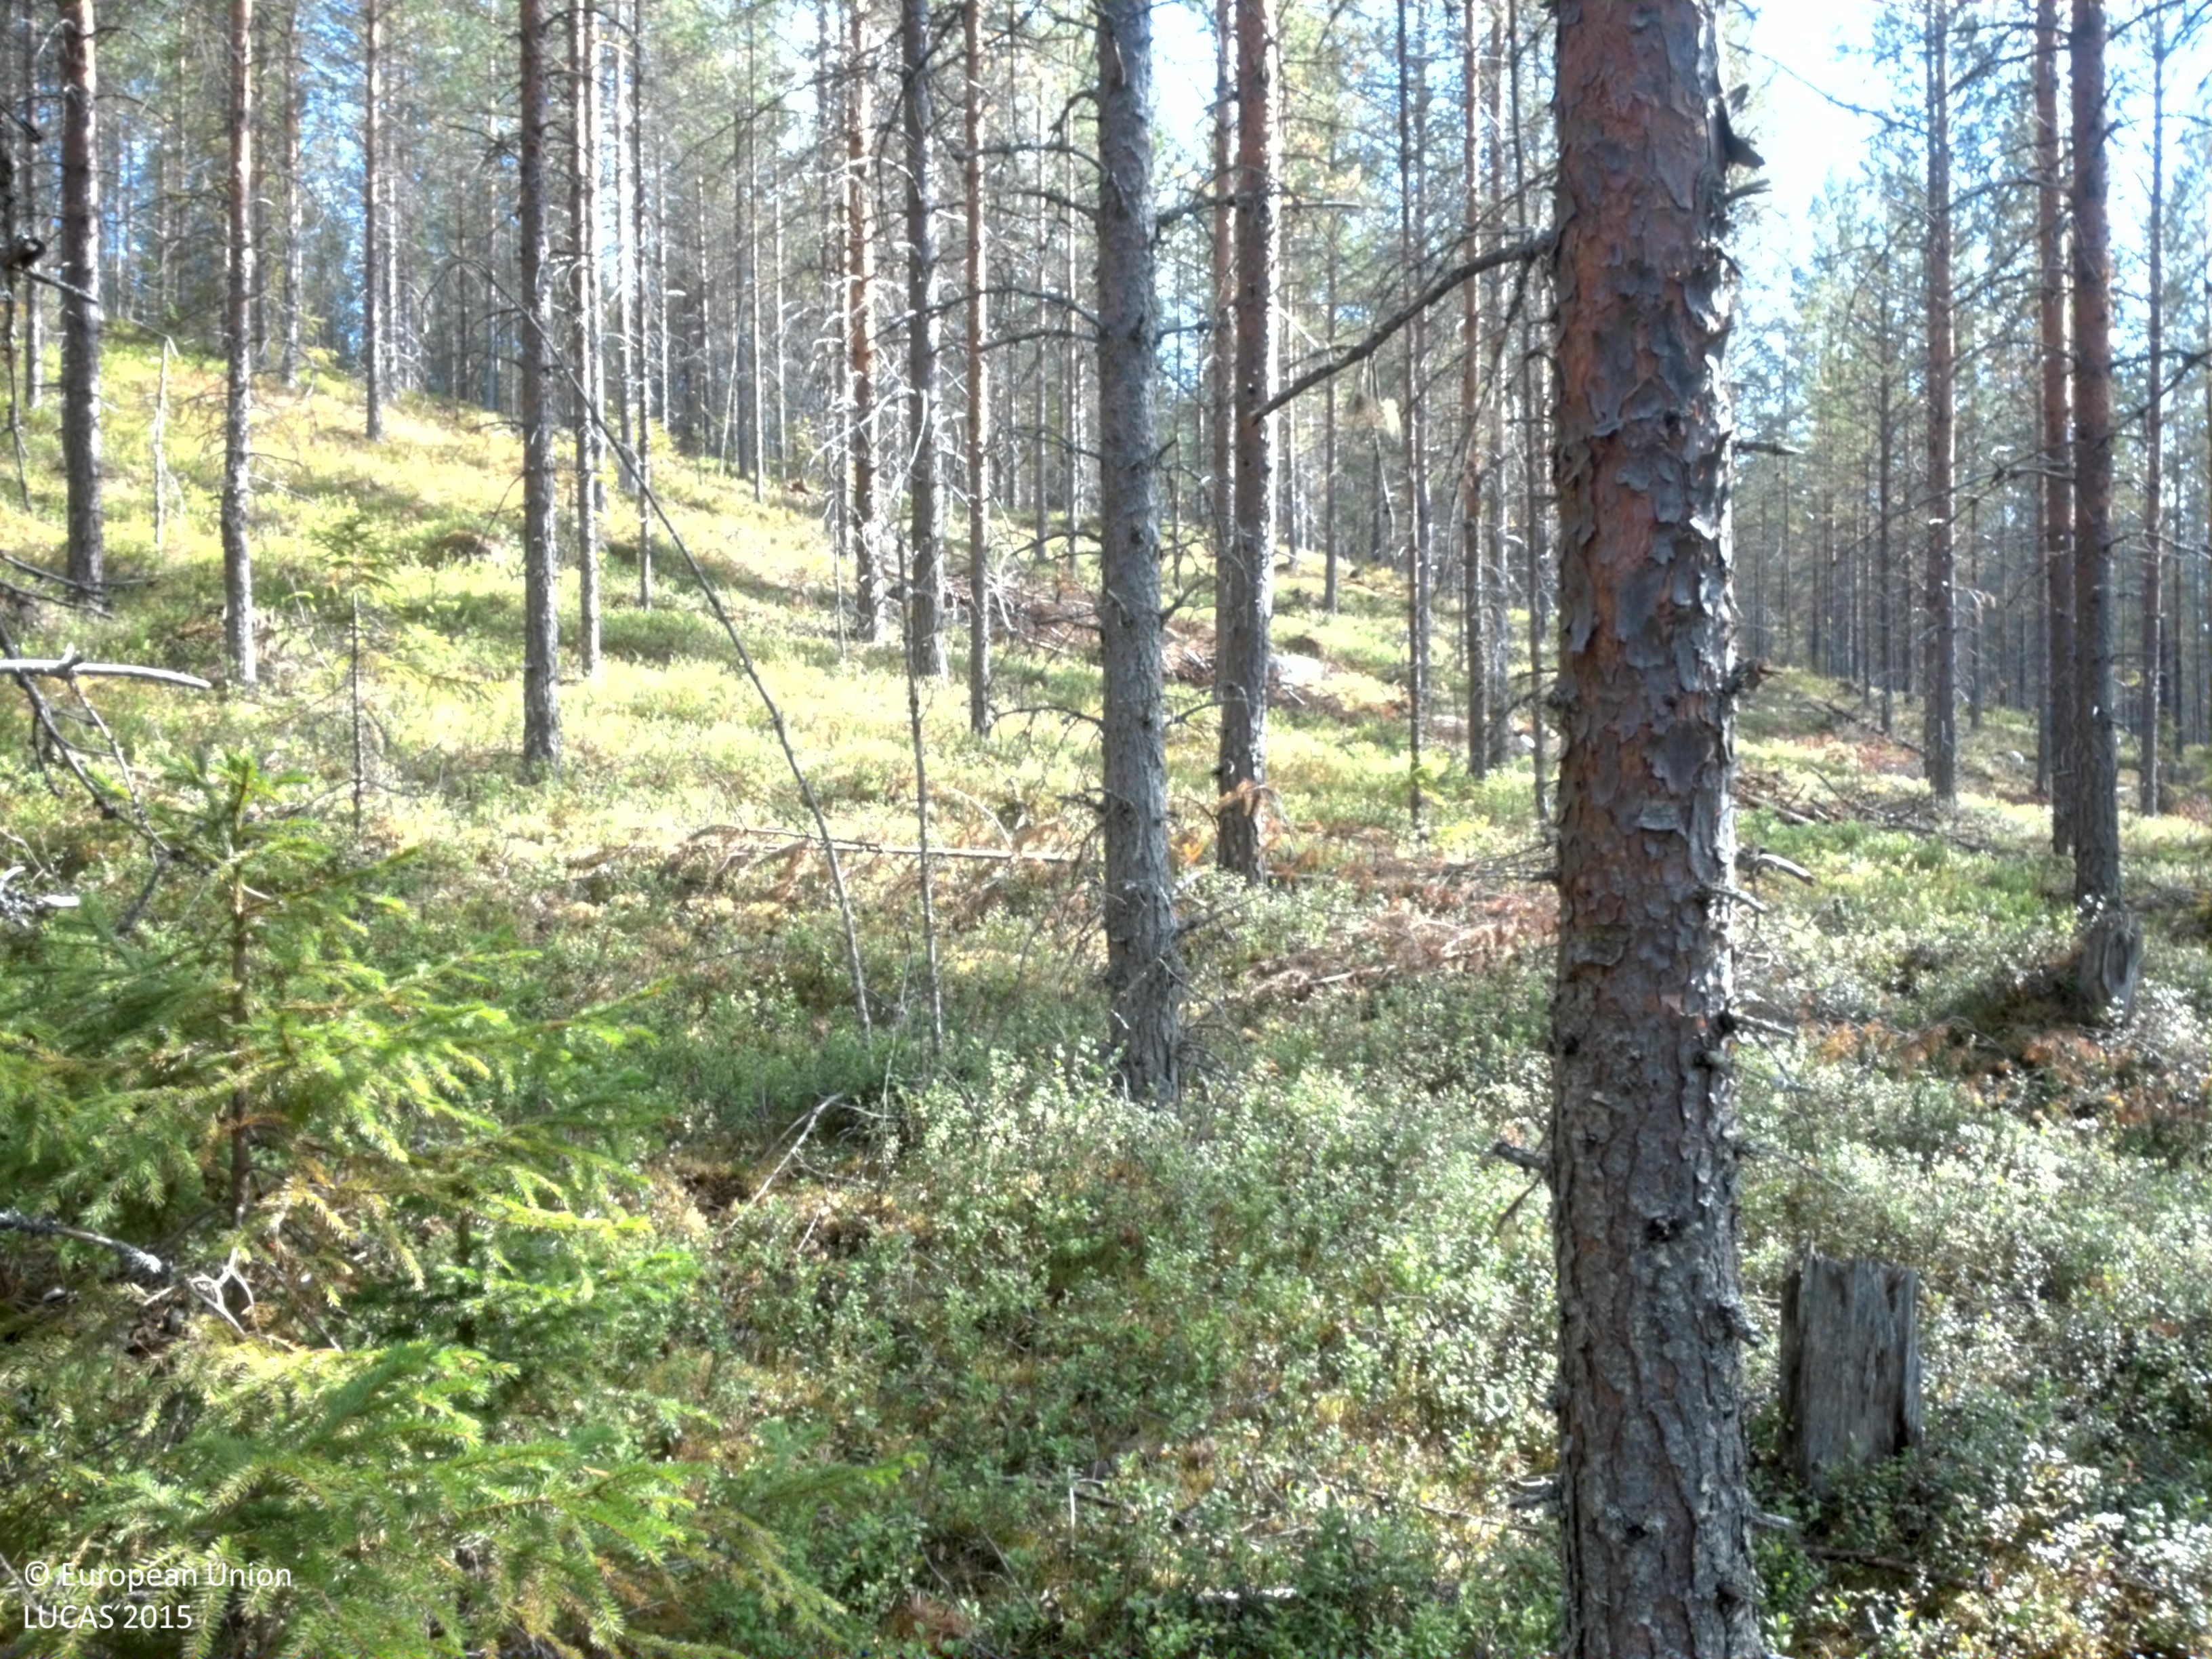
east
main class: Woodland
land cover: Pine dominated coniferous woodland
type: boreal forest
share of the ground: 50 - 75 %
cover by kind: coniferous forest trees 55 %, shrubs 40 %, lichens and mosses 5 %
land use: Forestry
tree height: > 5 m
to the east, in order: Pine dominated coniferous woodland
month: August
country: SE
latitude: 64.5964
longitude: 19.0152
